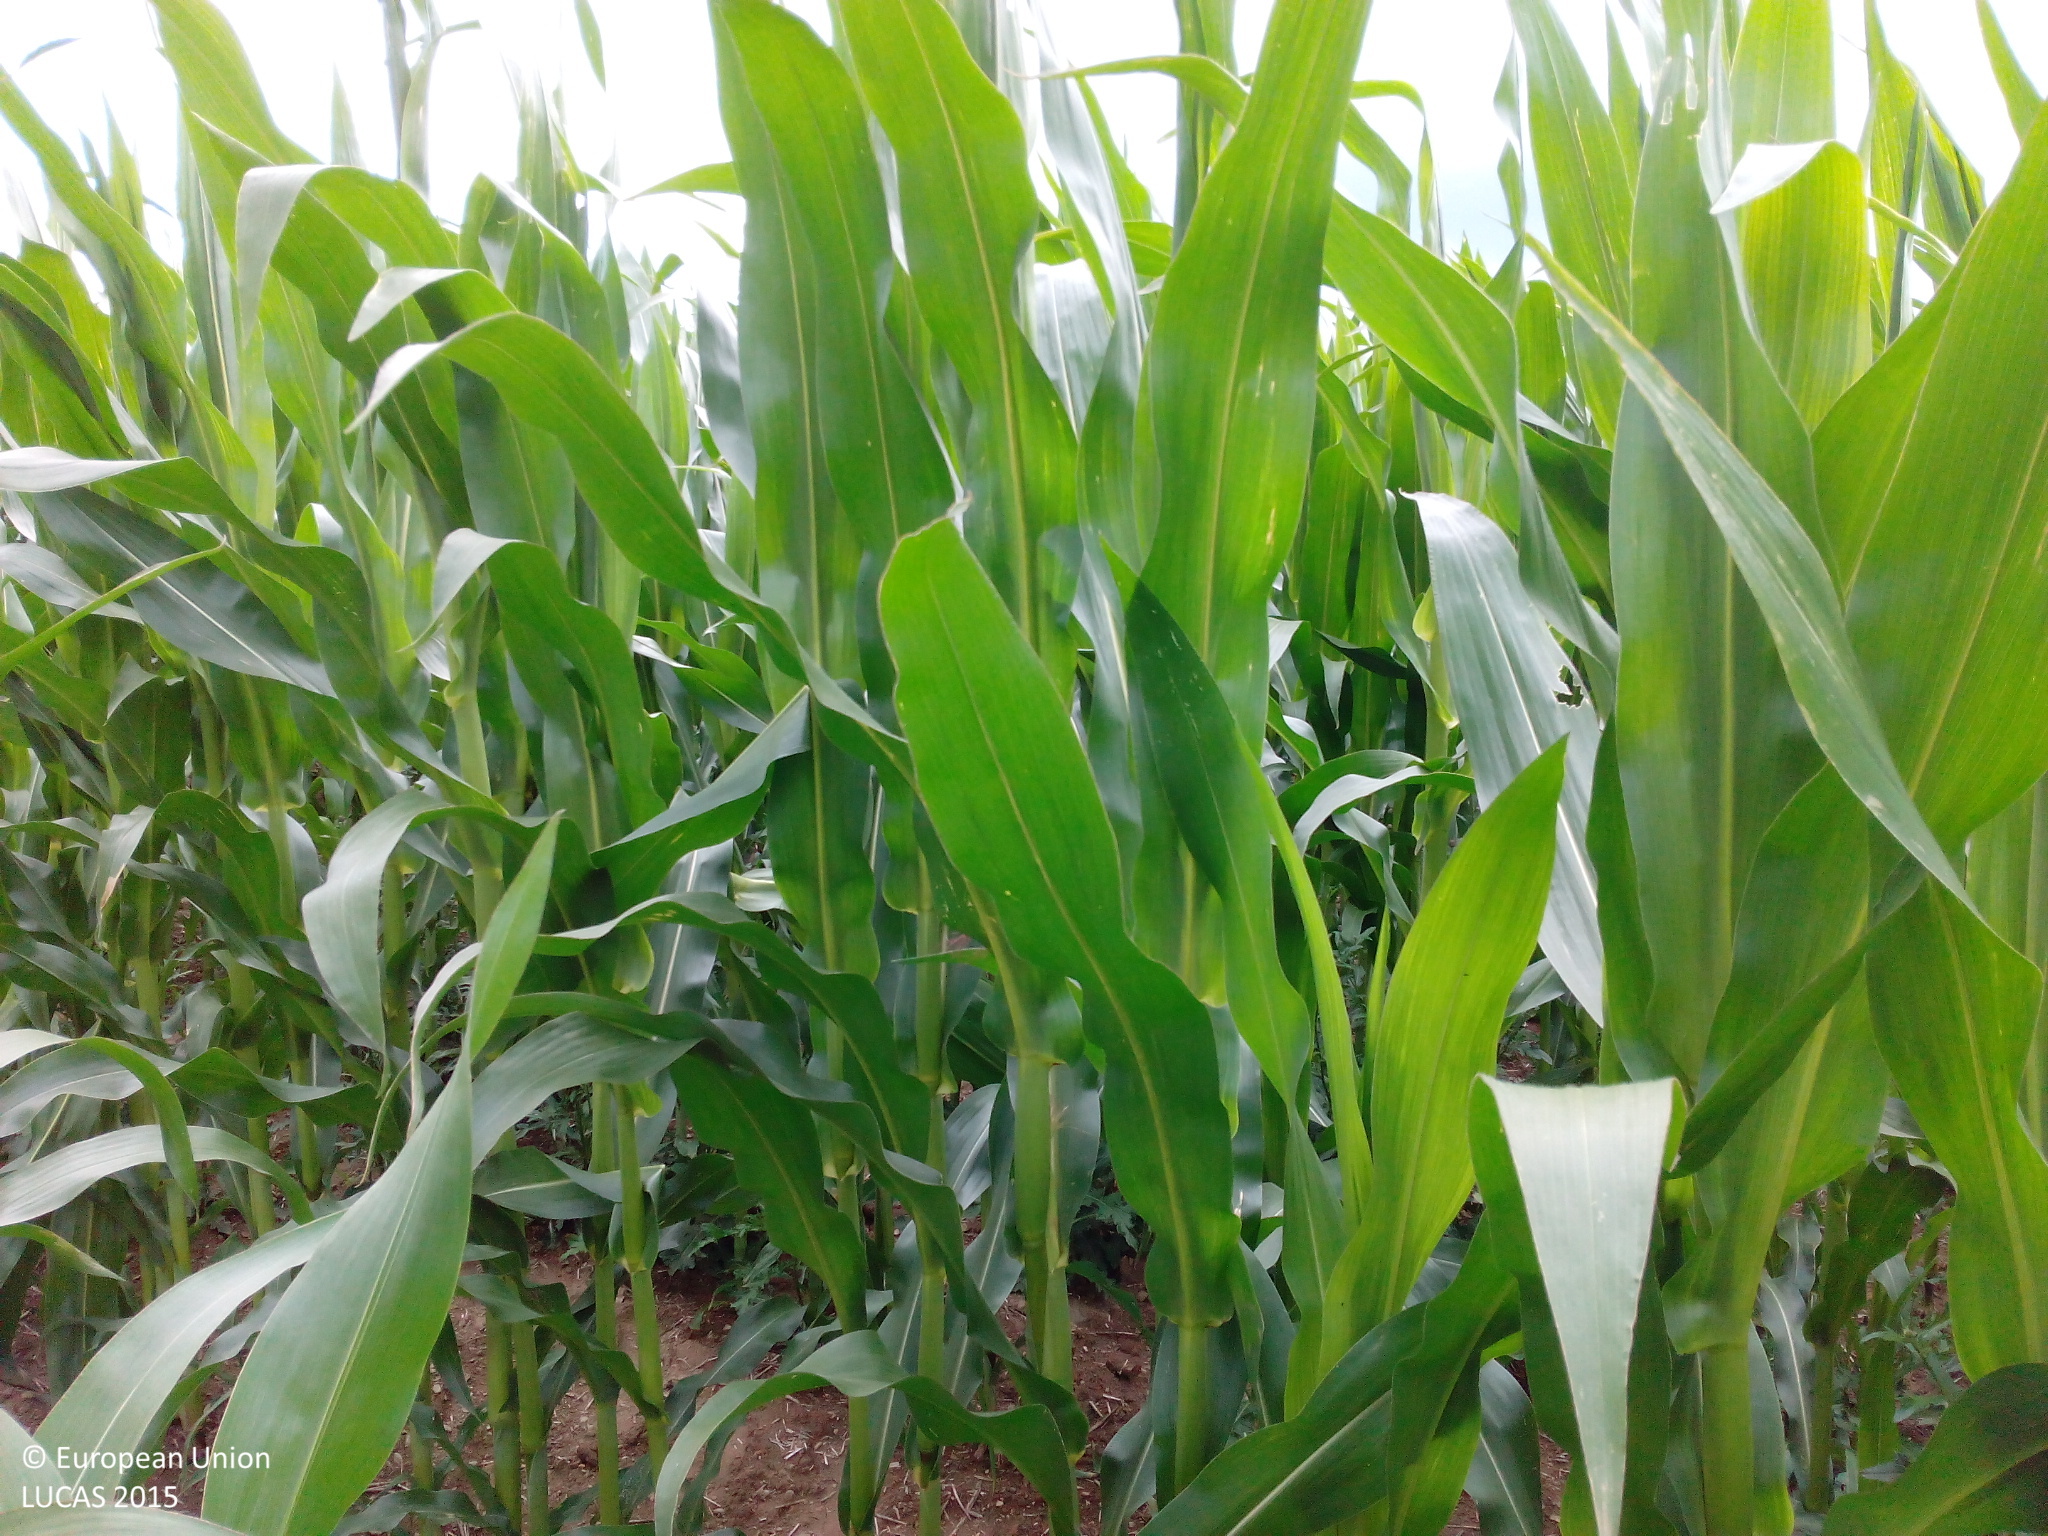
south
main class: Cropland
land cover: Maize
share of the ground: > 75 %
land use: Agriculture (excluding fallow land and kitchen gardens)
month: July
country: DE
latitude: 49.8159
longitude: 12.4596
